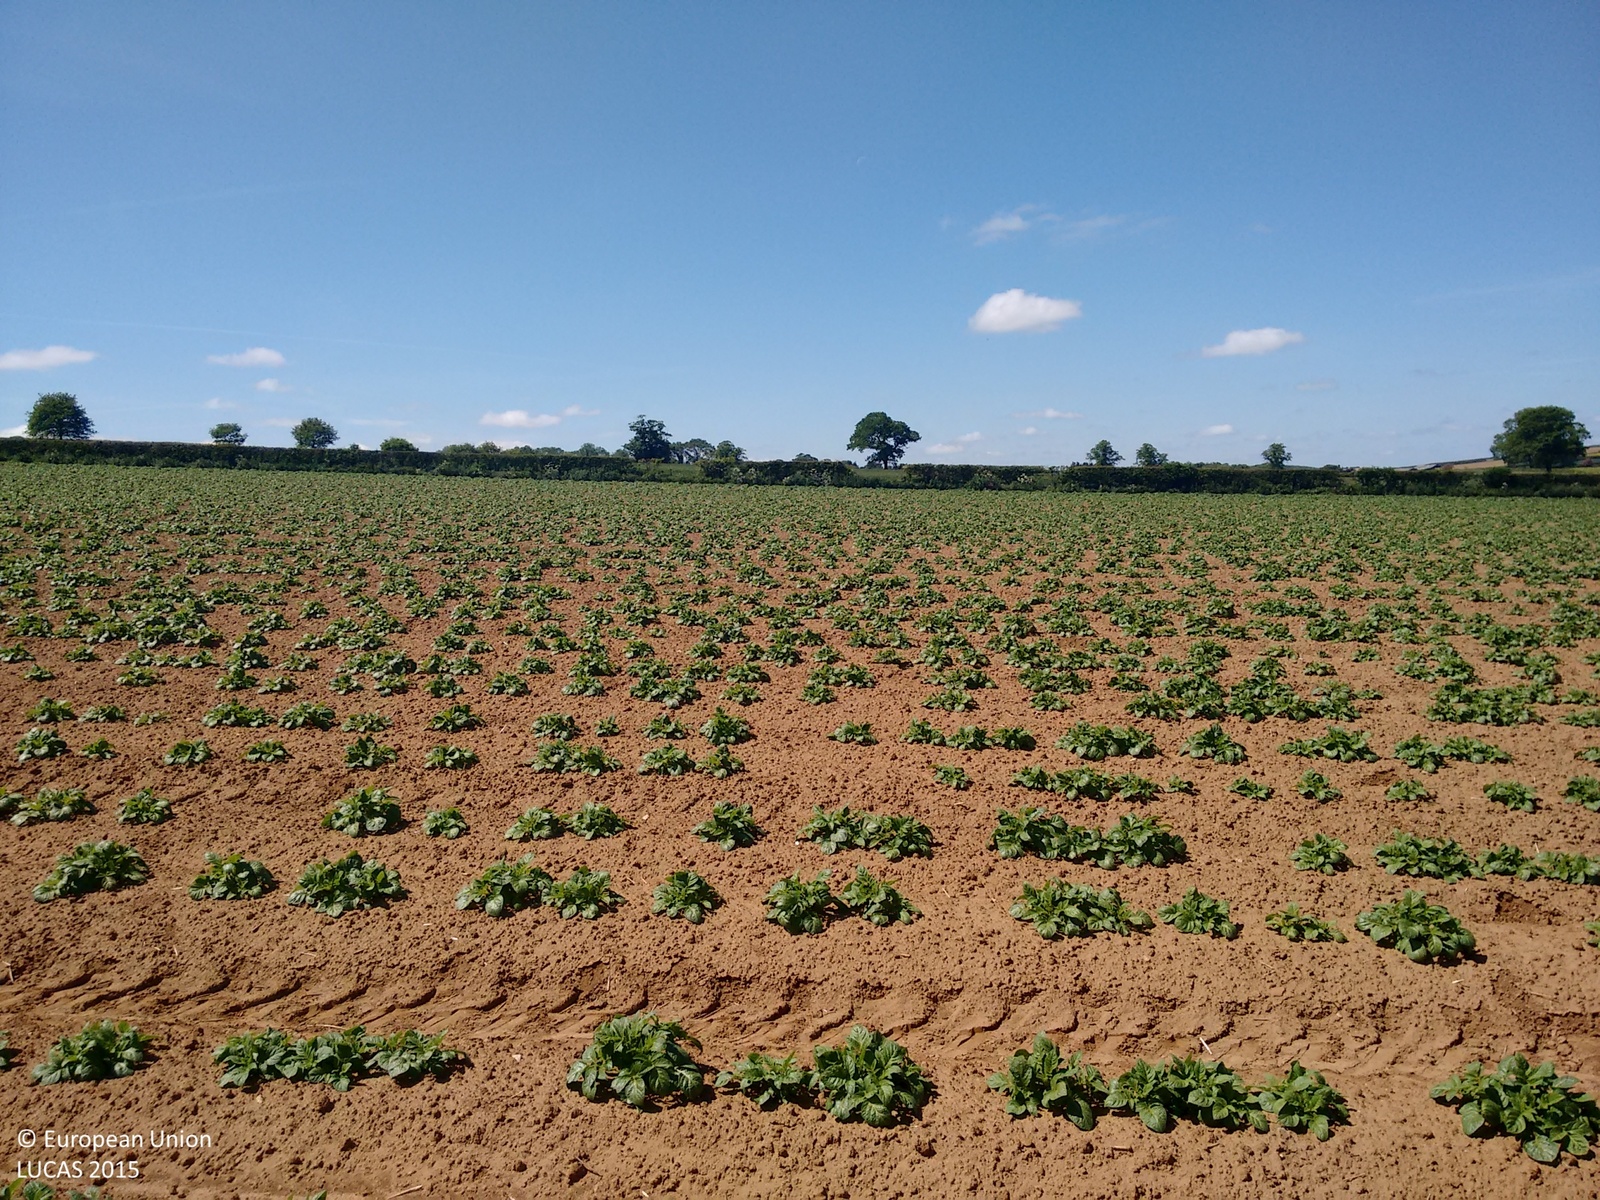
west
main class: Cropland
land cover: Potatoes
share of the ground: 10 - 25 %
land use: Agriculture (excluding fallow land and kitchen gardens)
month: June
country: GB
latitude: 54.1048
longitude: -0.9155
